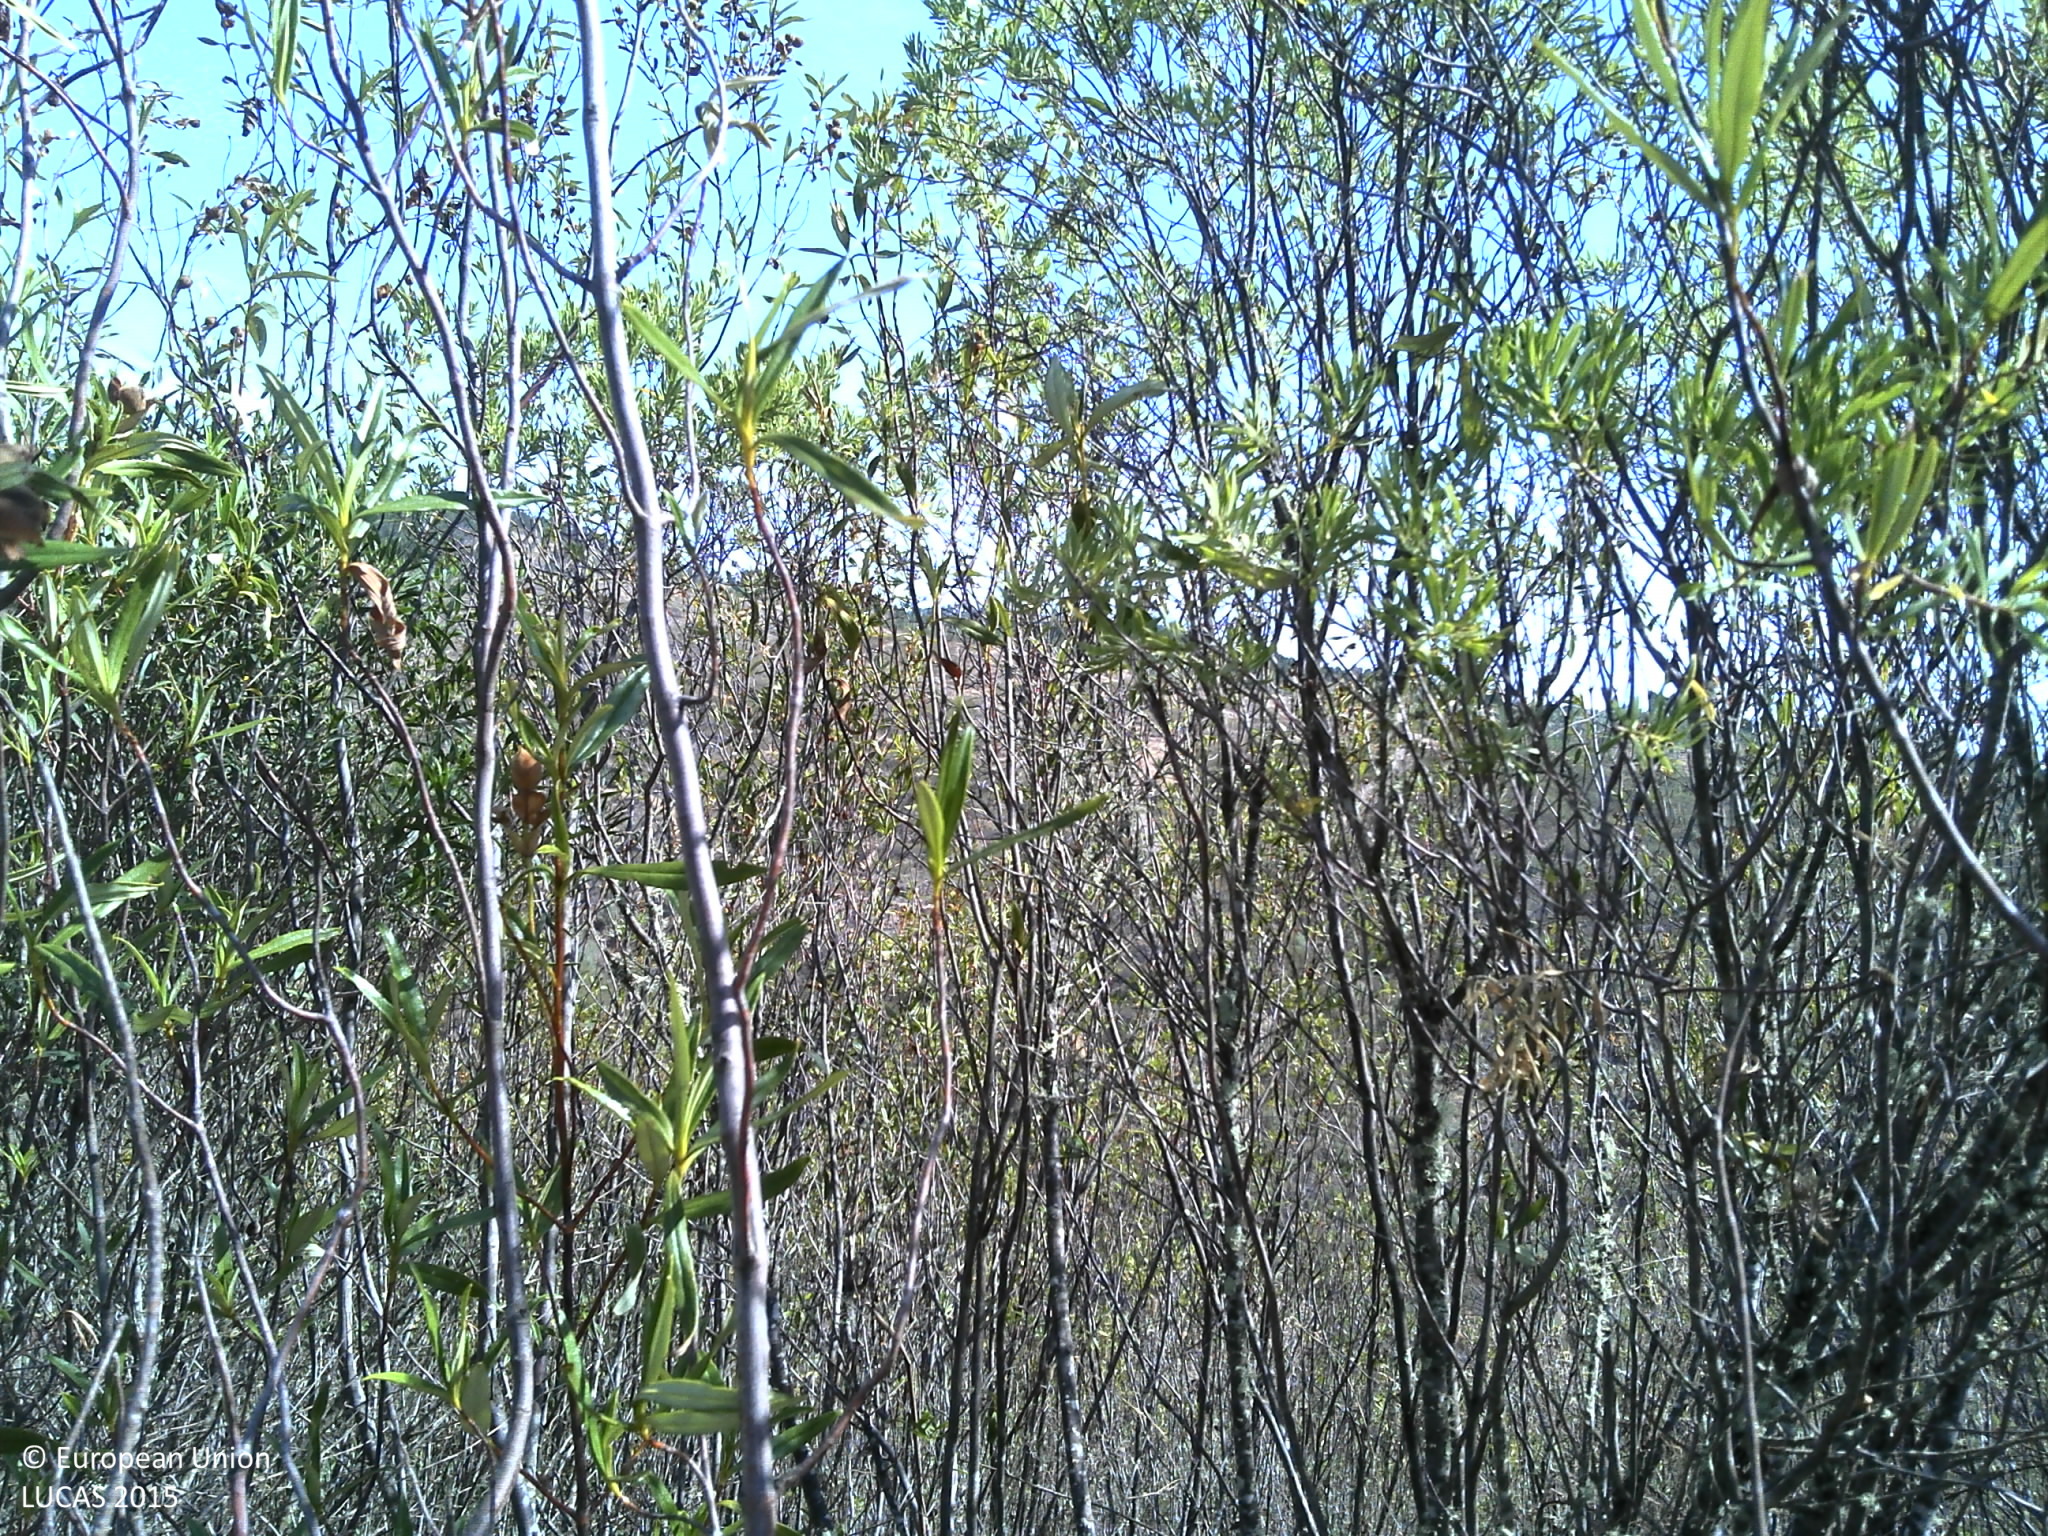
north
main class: Shrubland
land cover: Shrubland without tree cover
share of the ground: 50 - 75 %
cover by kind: shrubs 75 %, unconsolidated bare surface 25 %
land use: Semi-natural and natural areas not in use
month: July
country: PT
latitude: 39.4877
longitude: -7.9277
